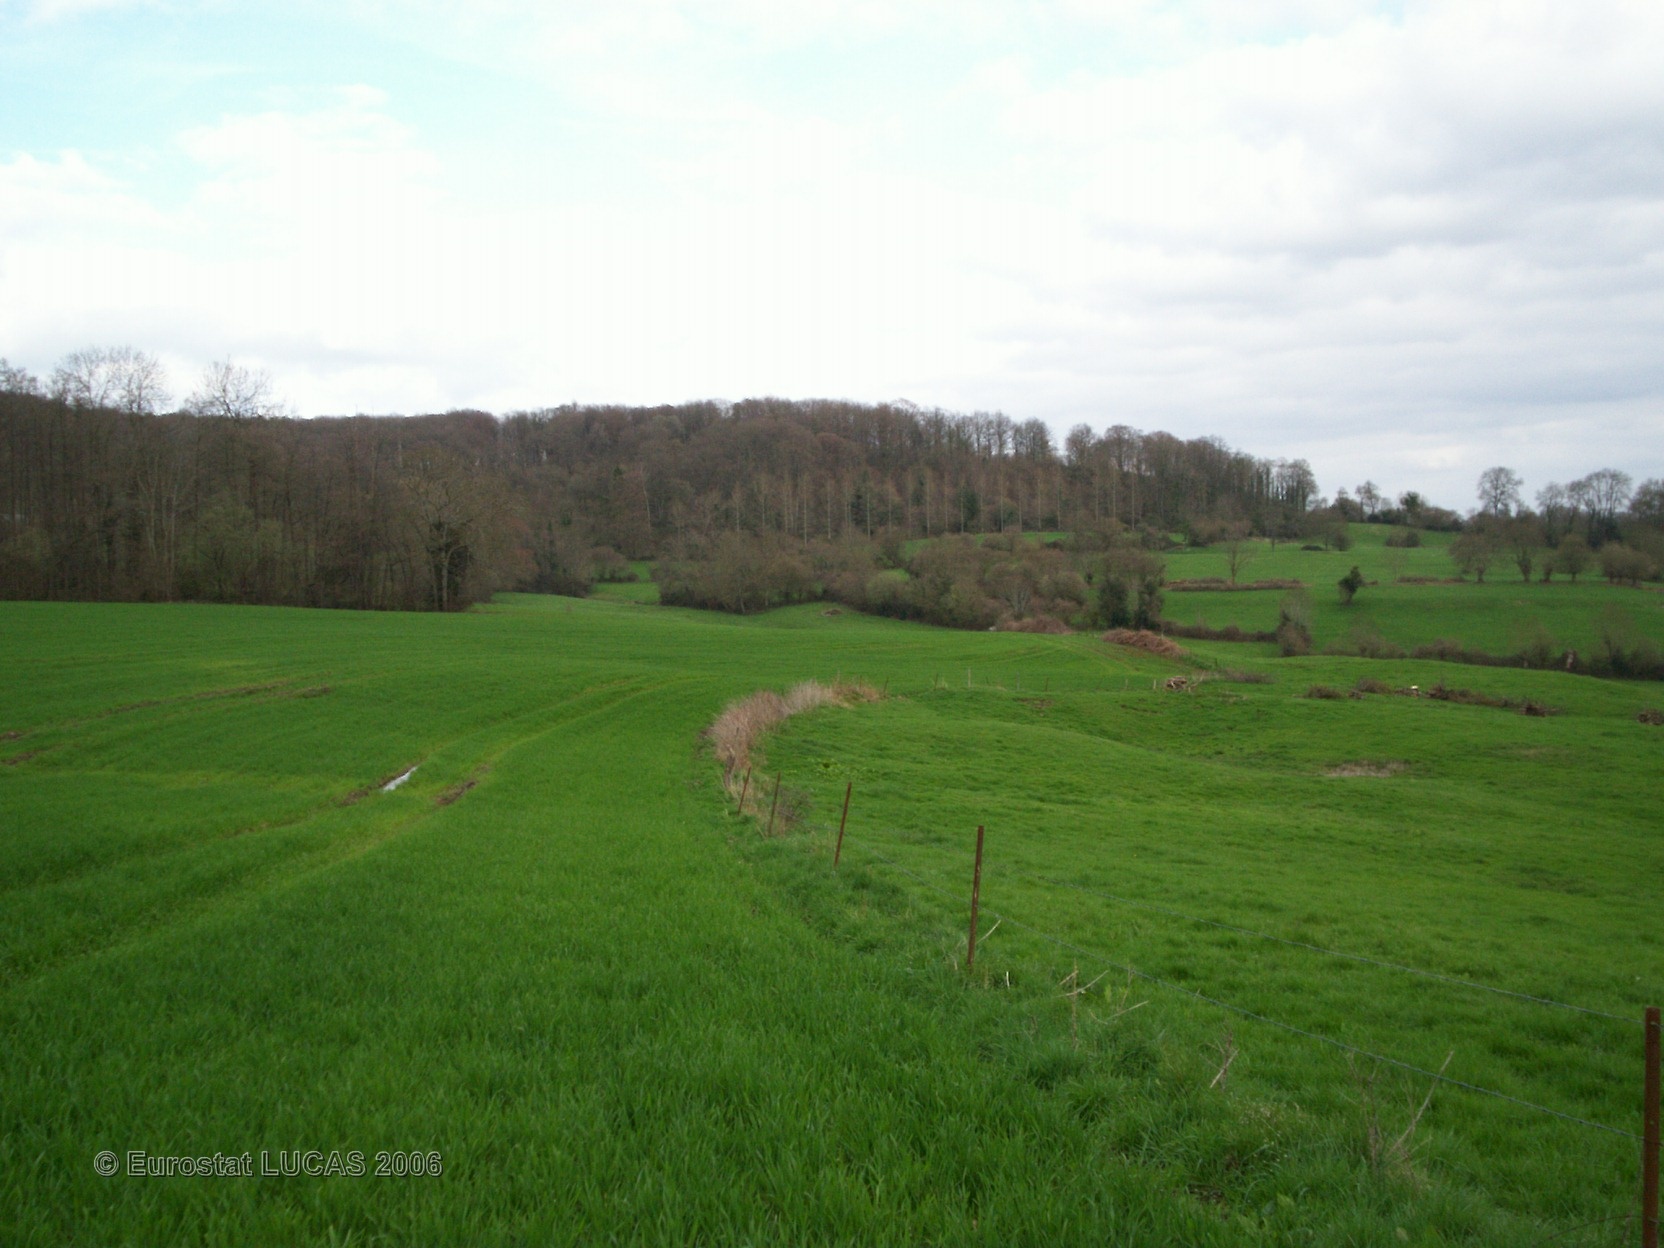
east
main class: Cropland
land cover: Common wheat
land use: Agriculture (excluding fallow land and kitchen gardens)
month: April
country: FR
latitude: 48.8811
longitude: 0.0840
